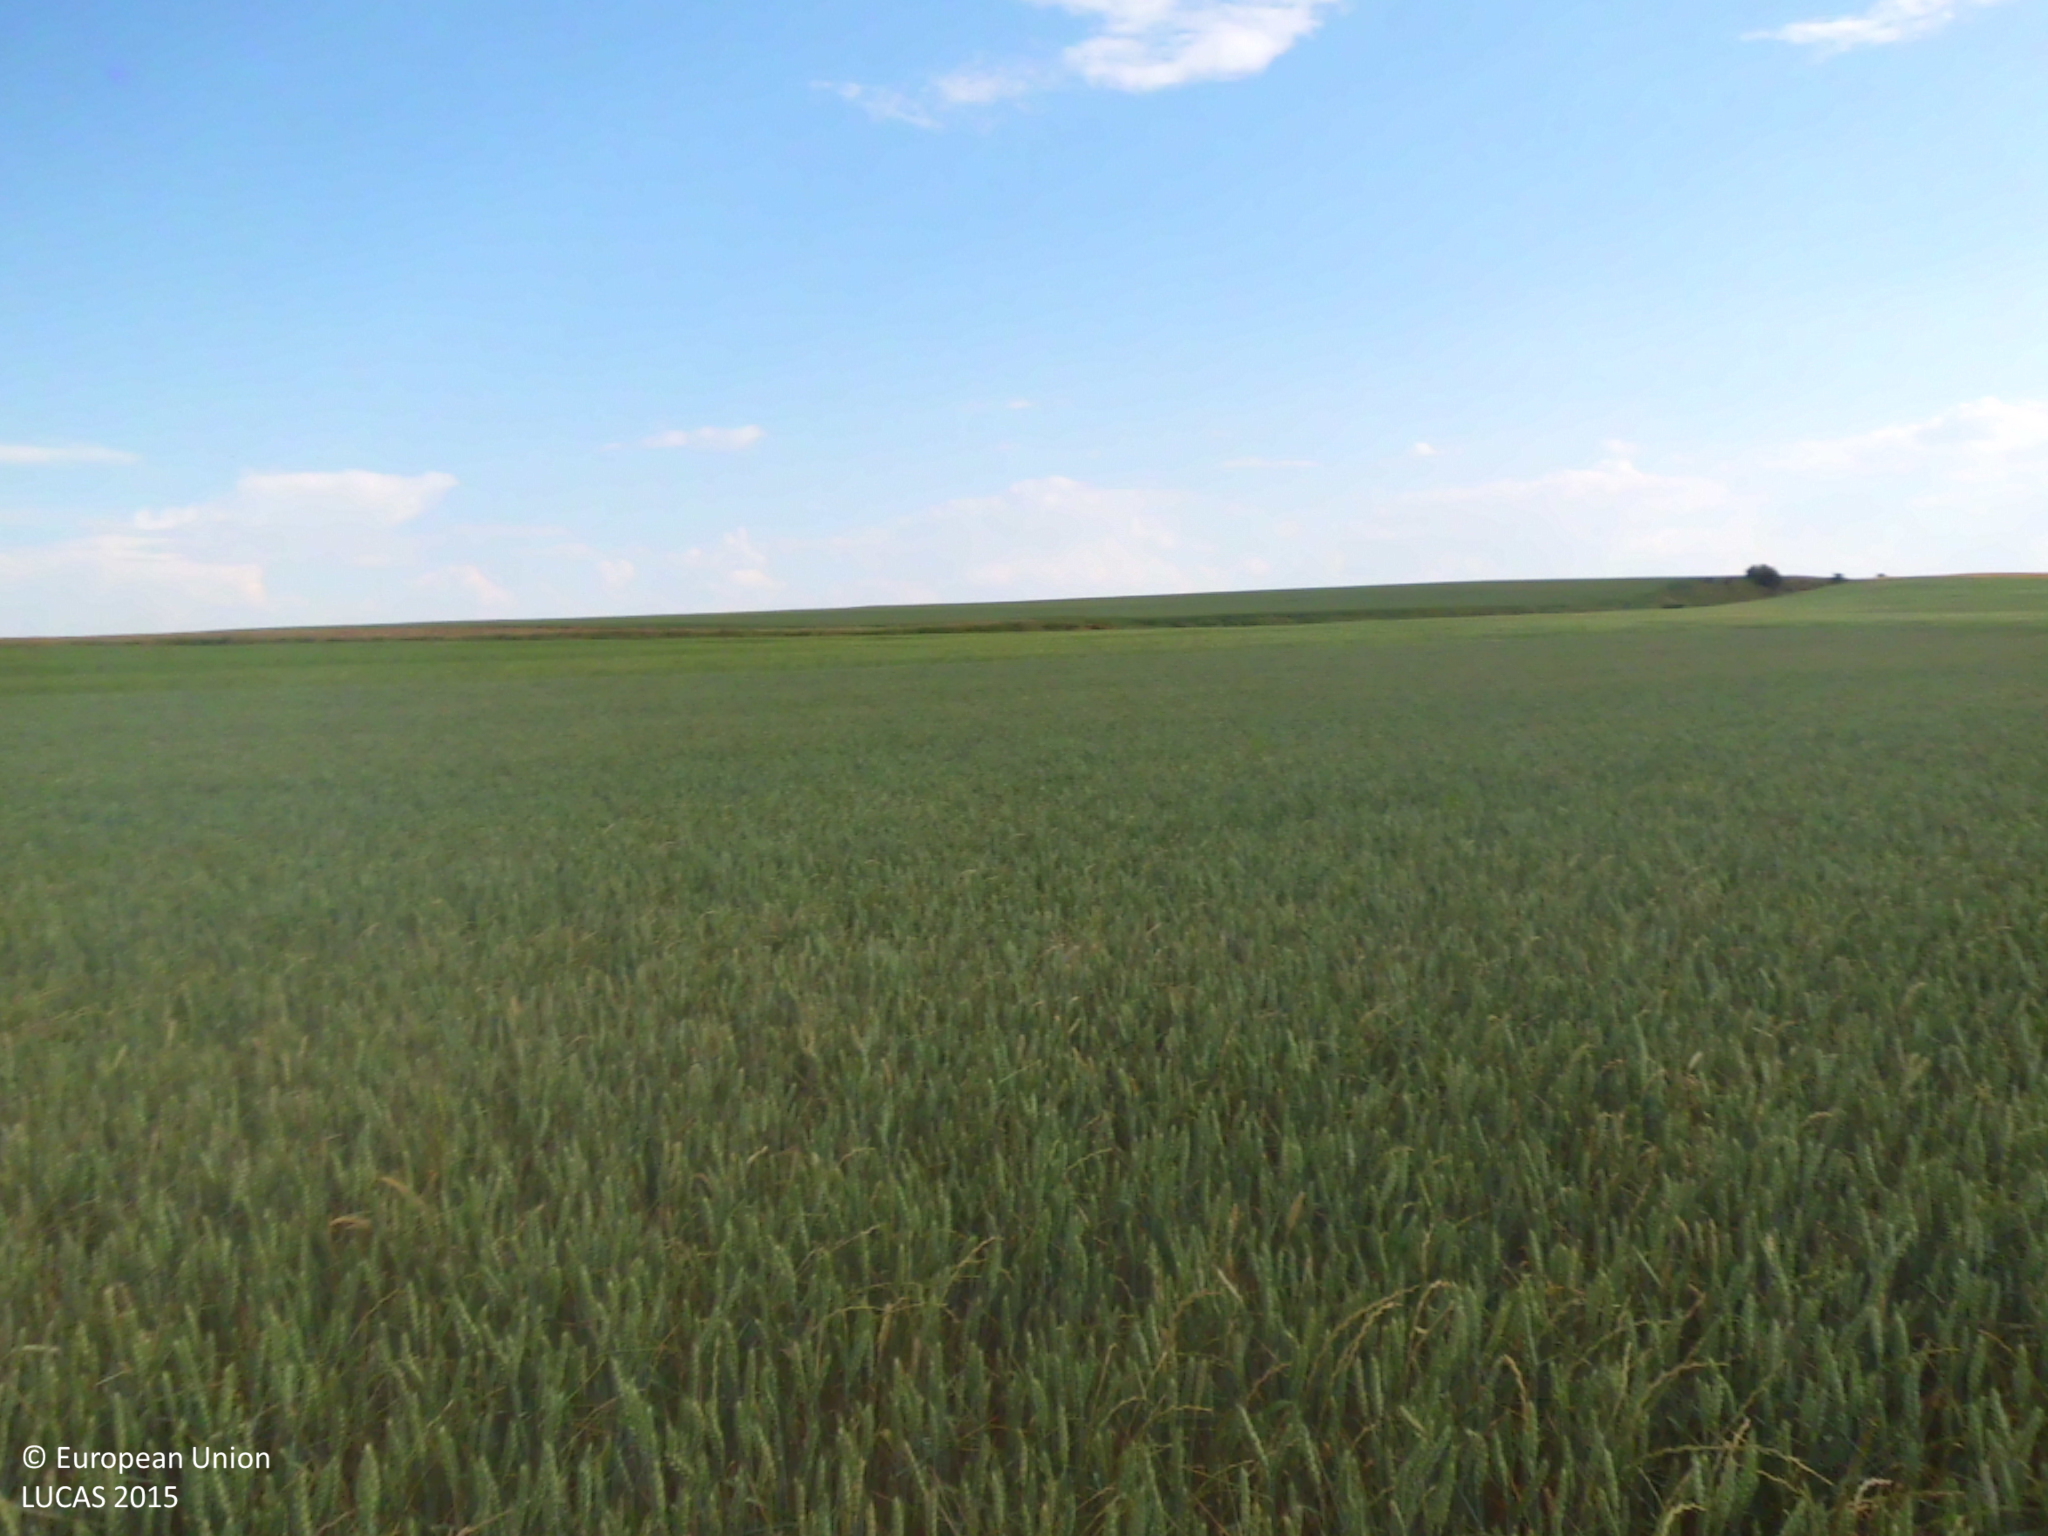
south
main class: Cropland
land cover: Common wheat
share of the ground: > 75 %
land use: Agriculture (excluding fallow land and kitchen gardens)
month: June
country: ES
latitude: 42.5163
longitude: -4.3999
